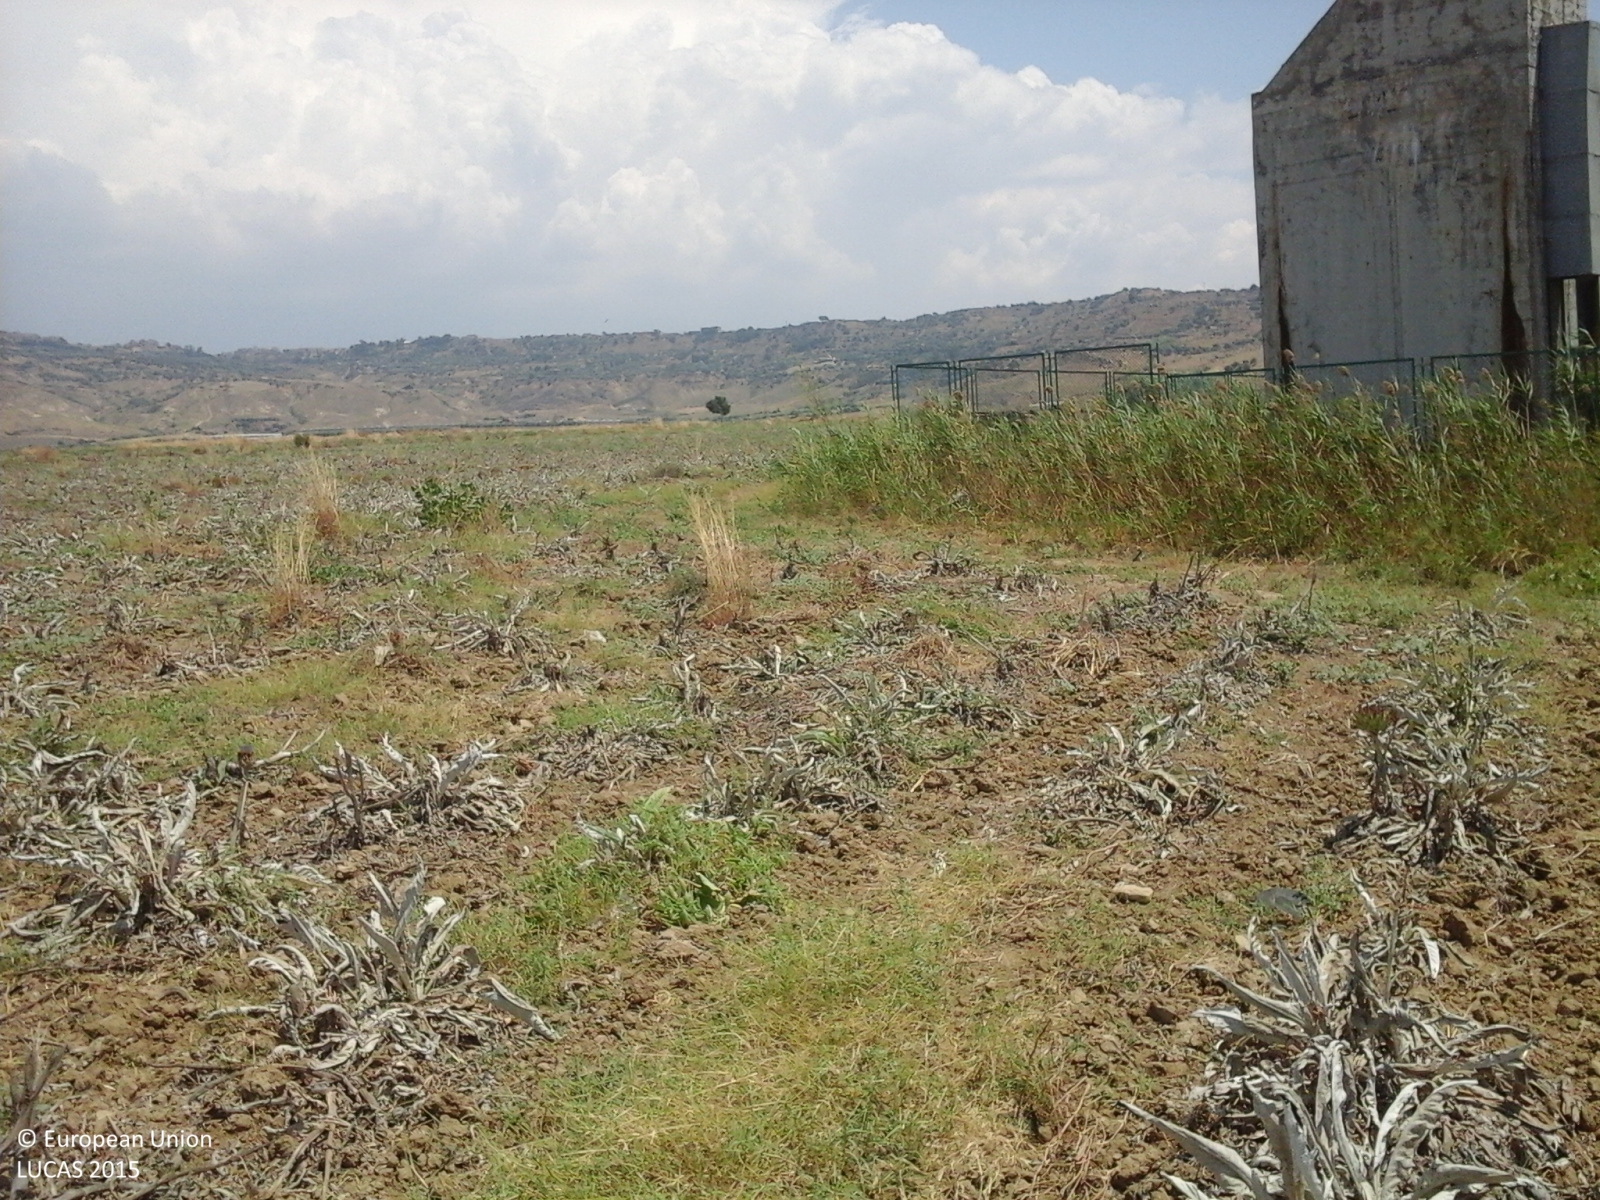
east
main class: Cropland
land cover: Other fresh vegetables
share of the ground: > 75 %
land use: Agriculture (excluding fallow land and kitchen gardens)
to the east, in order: Other fresh vegetables; Grass margins; Artificial constructions in urban areas; Grass margins; Other fresh vegetables; Grassland without tree/shrub cover; Ditches and canals; Grass margins; Paved roads, cycling and walking lanes; Grass margins; Temporary grasslands; Ditches and canals; Temporary grasslands
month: July
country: IT
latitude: 37.1200
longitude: 14.3665
